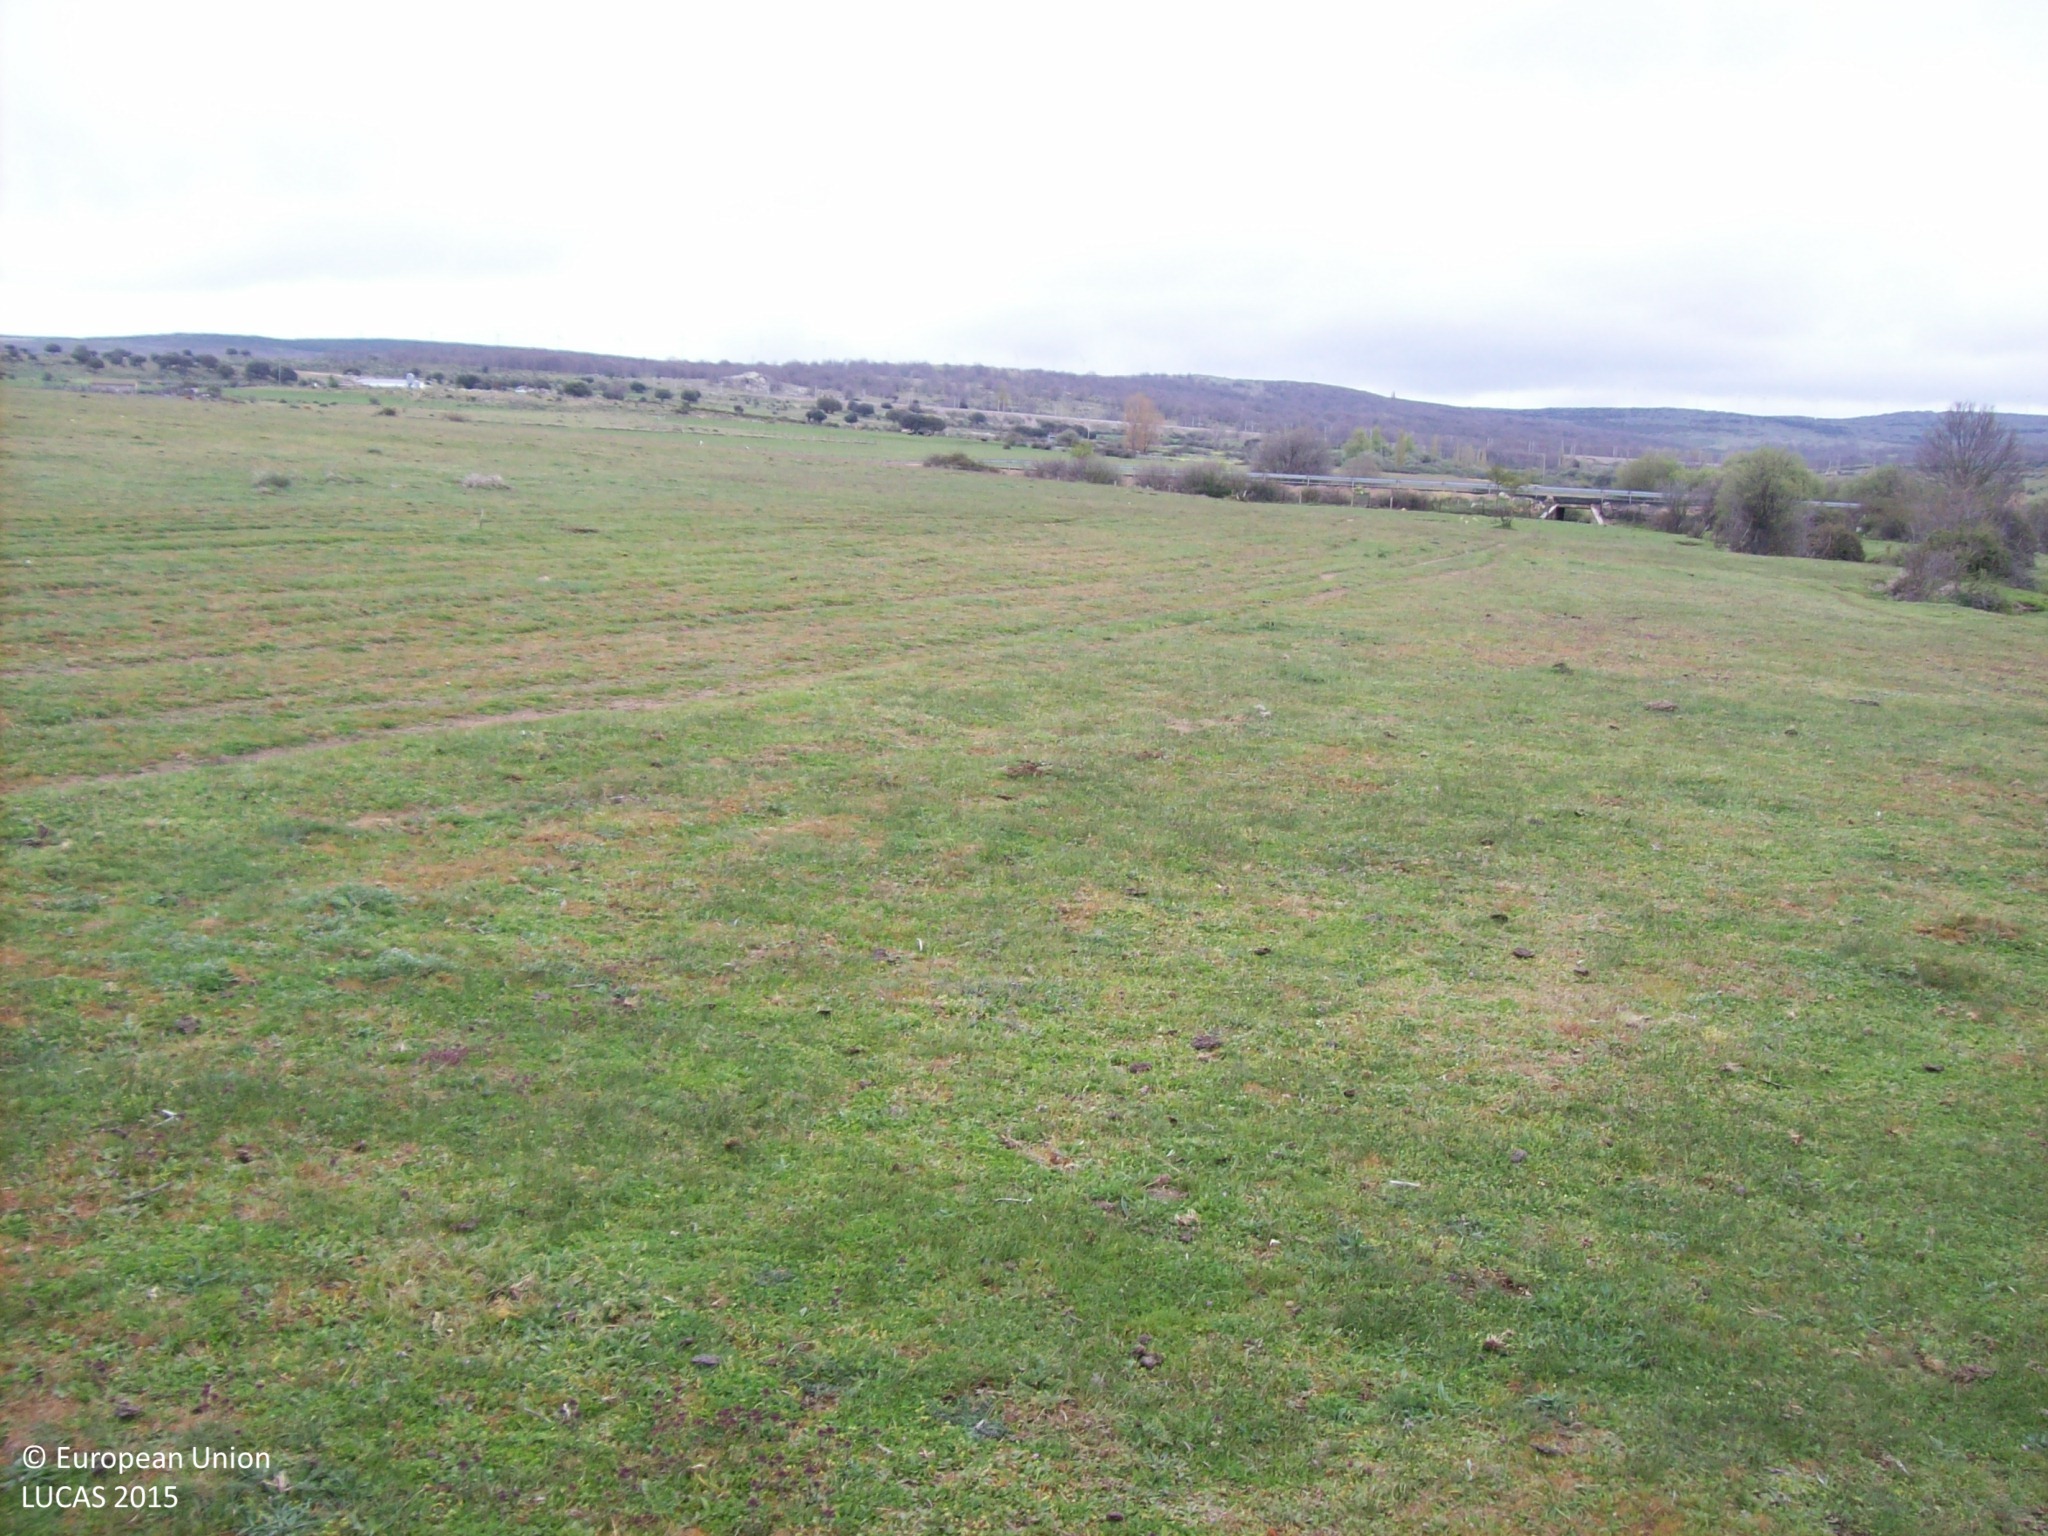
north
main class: Grassland
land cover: Grassland without tree/shrub cover
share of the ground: > 75 %
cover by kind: herbaceous plants 95 %
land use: Agriculture (excluding fallow land and kitchen gardens)
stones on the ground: < 10 %
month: April
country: ES
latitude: 40.5884
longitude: -4.4295
